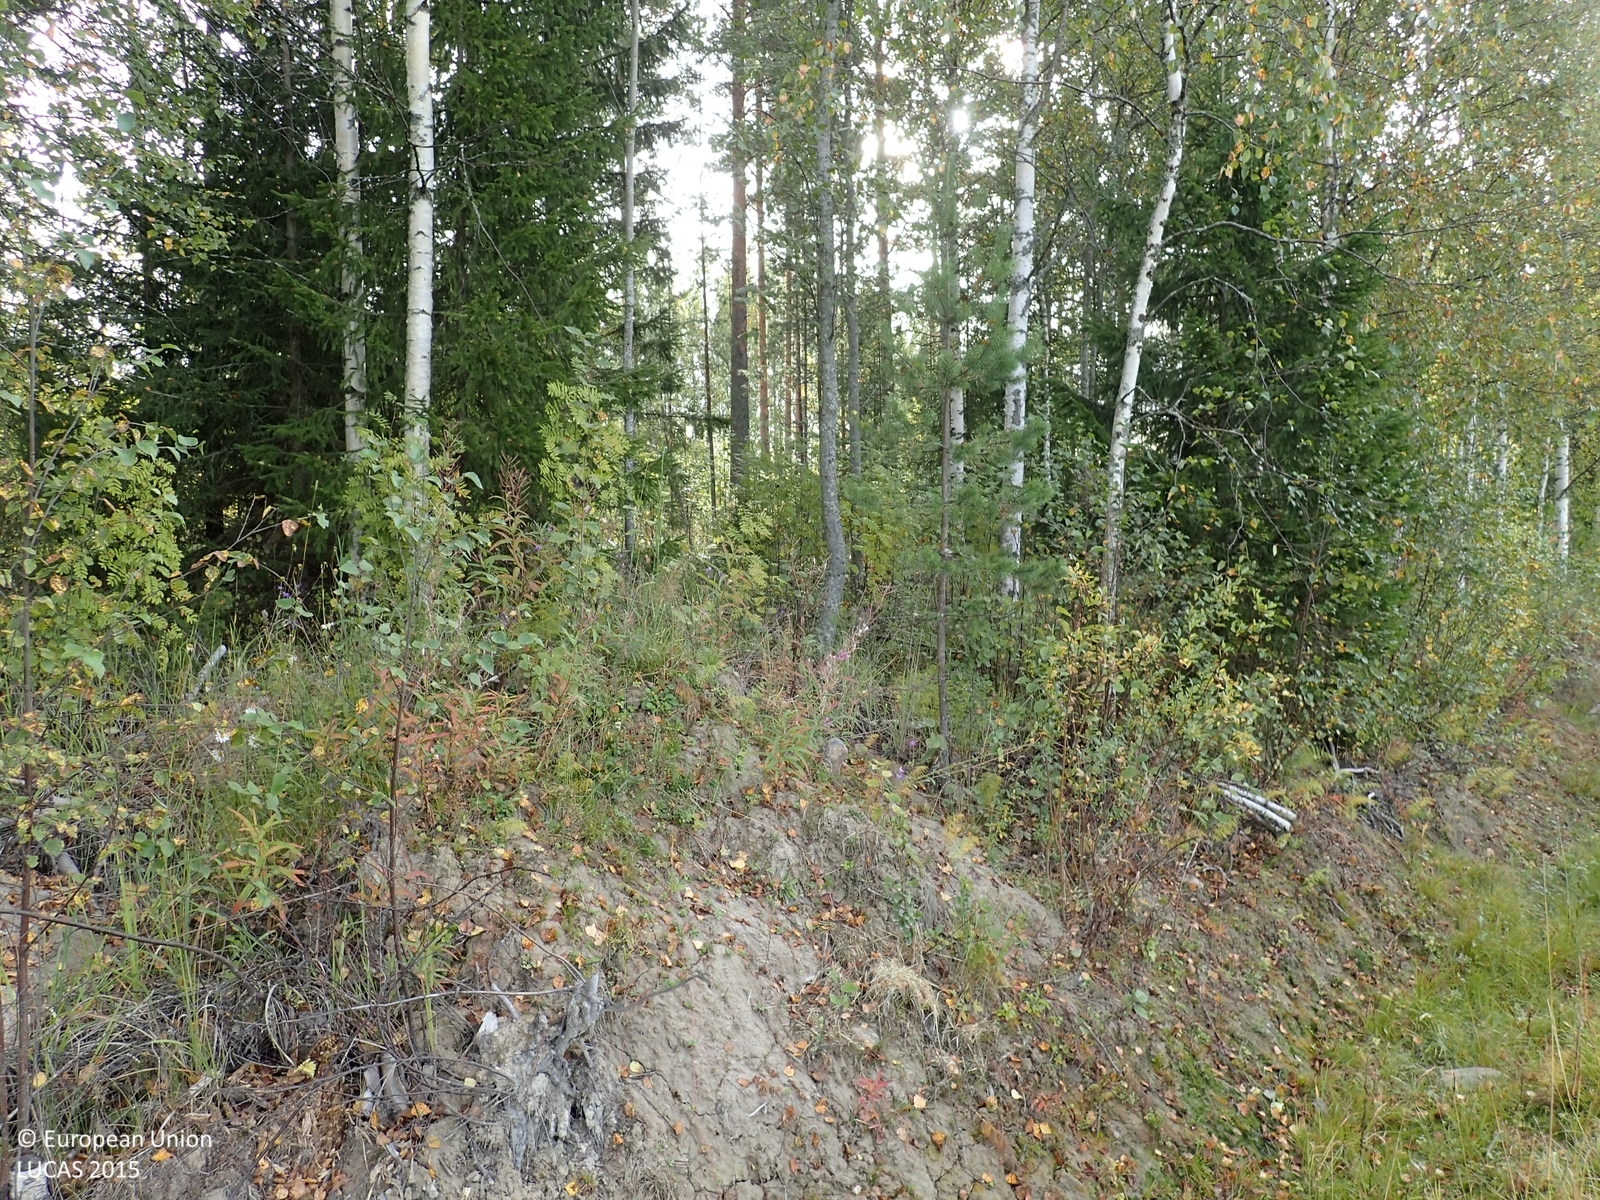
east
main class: Cropland
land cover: Temporary grasslands
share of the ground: > 75 %
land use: Agriculture (excluding fallow land and kitchen gardens)
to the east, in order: Temporary grasslands; Ditches and canals; Temporary grasslands; Ditches and canals; Temporary grasslands; Ditches and canals; Pine dominated mixed woodland; Grassland without tree/shrub cover; Paved roads, cycling and walking lanes; Grassland without tree/shrub cover; Ditches and canals; Electric lines; Broadleaved woodland; Artificial constructions in urban areas; Inland fresh water bodies
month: September
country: FI
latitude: 63.1203
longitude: 25.9570
